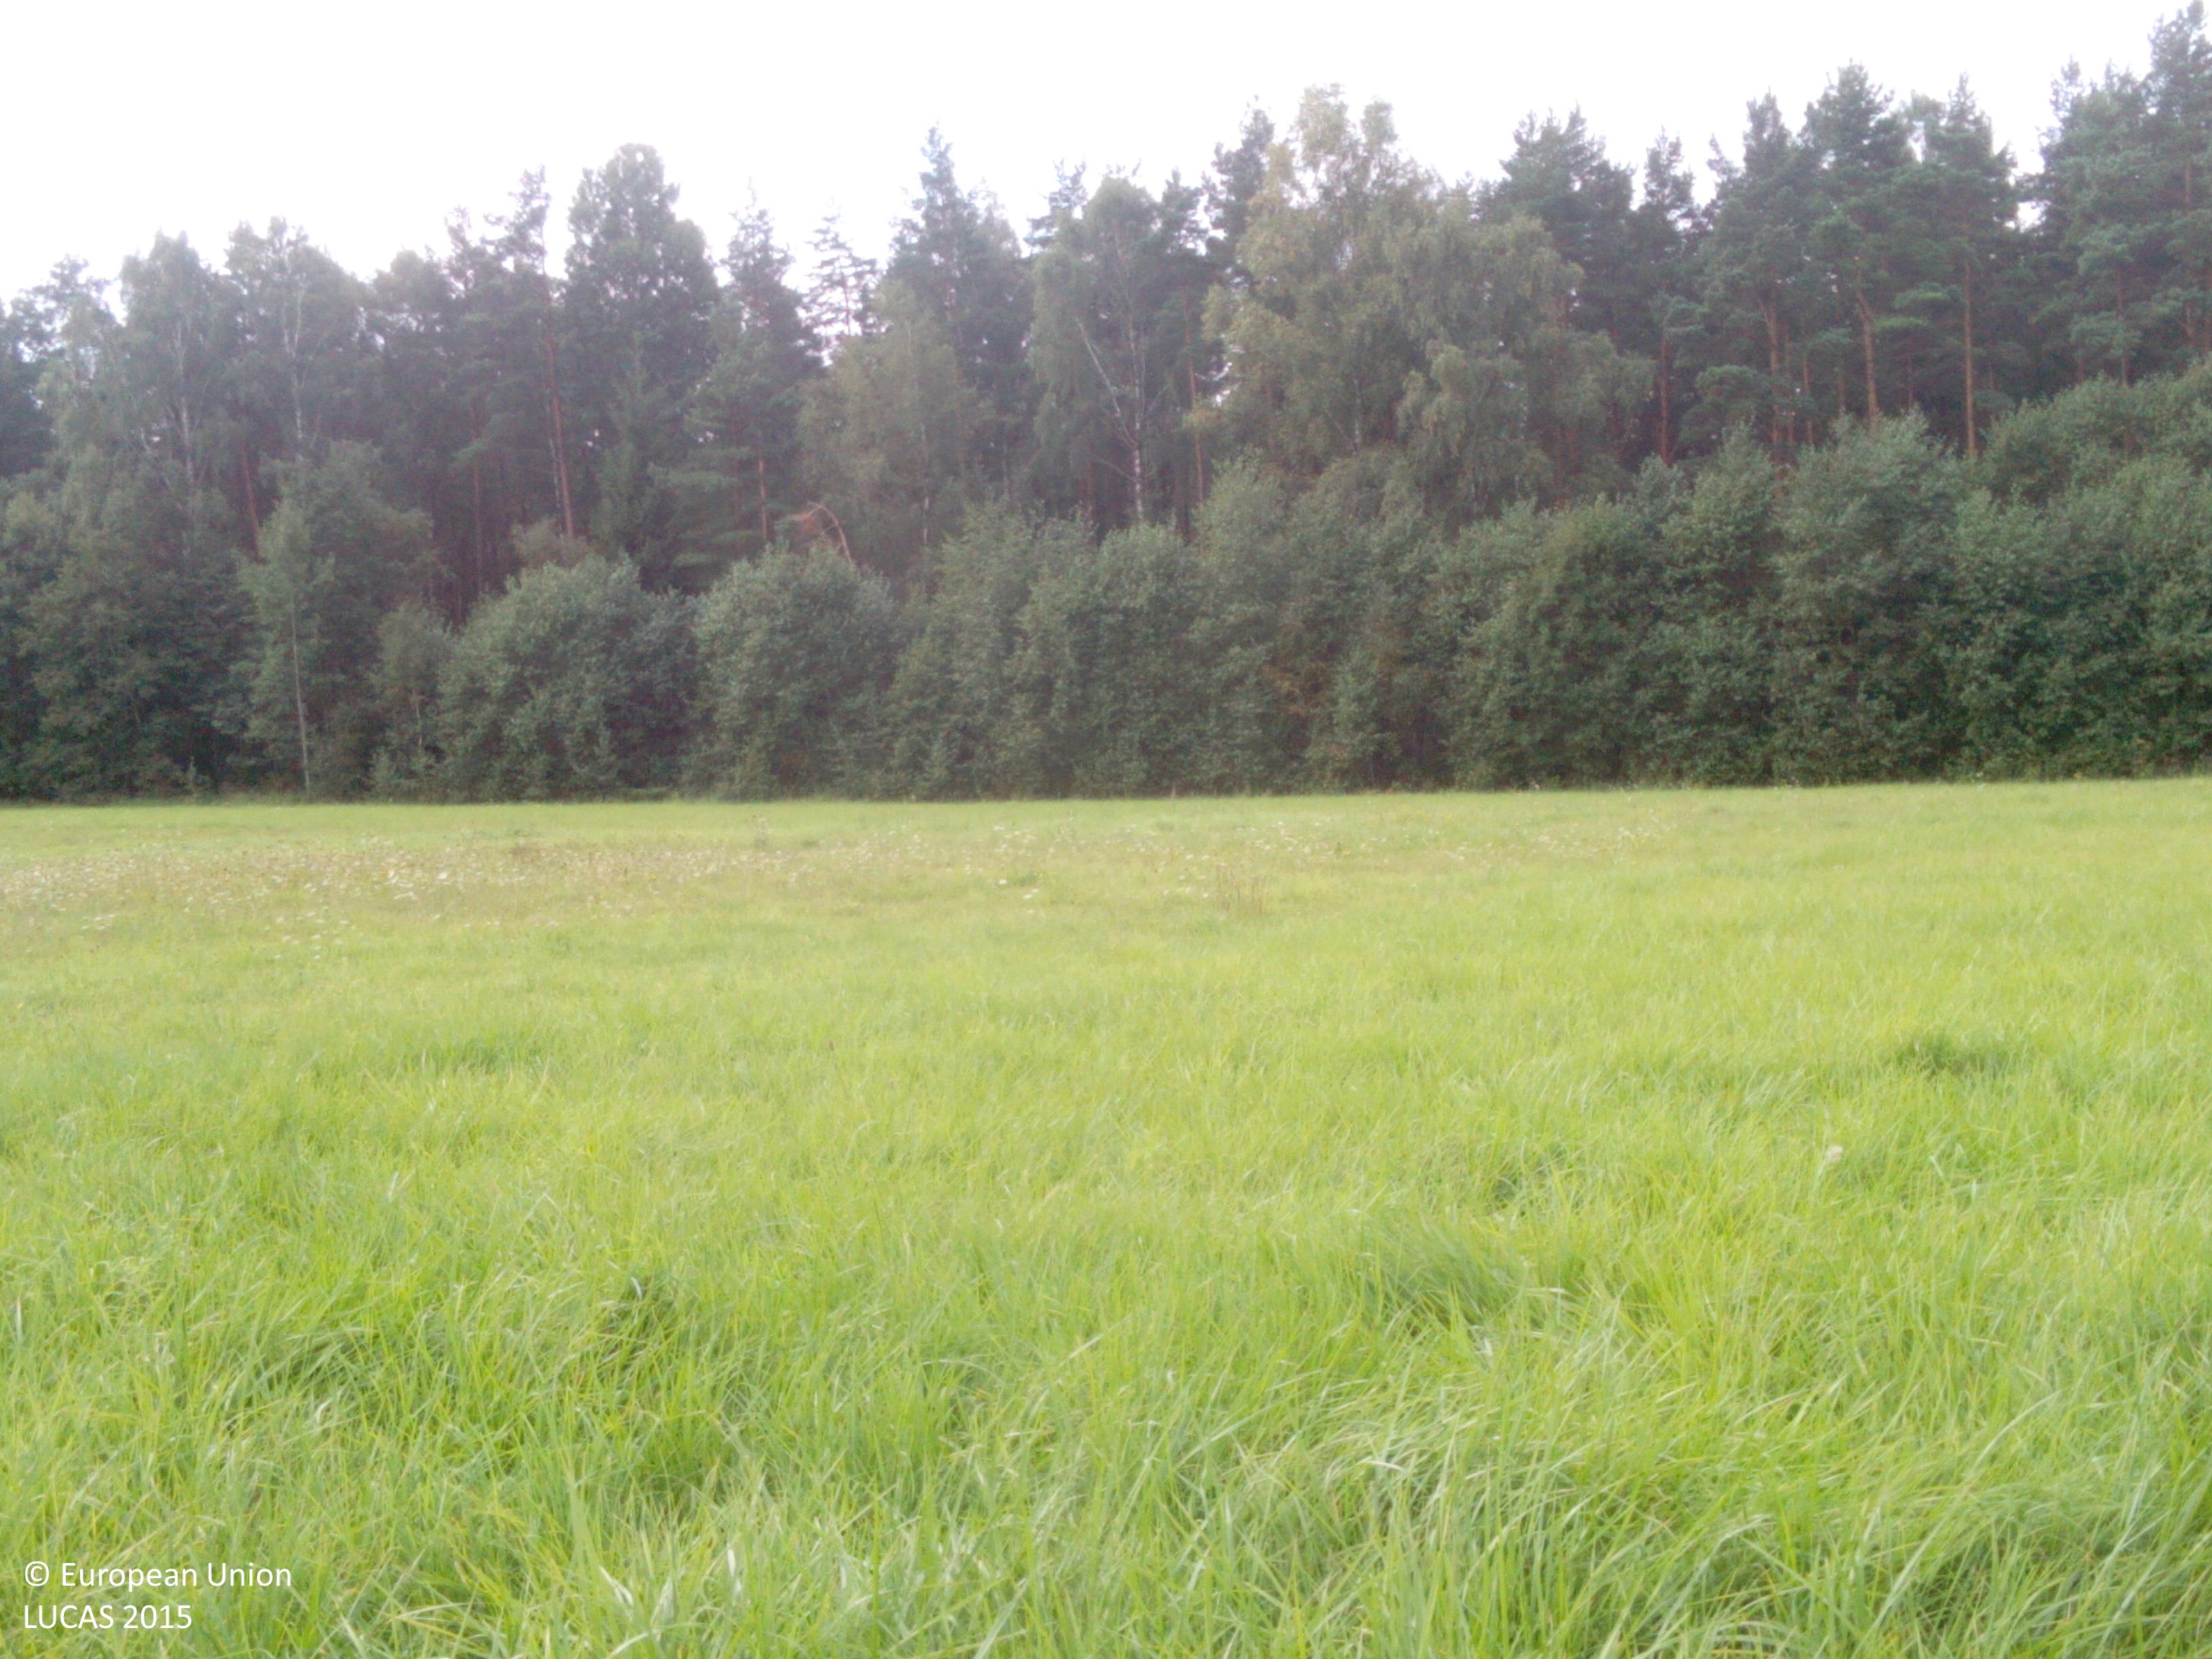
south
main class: Grassland
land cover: Grassland without tree/shrub cover
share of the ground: > 75 %
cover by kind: herbaceous plants 100 %
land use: Agriculture (excluding fallow land and kitchen gardens)
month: August
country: LV
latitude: 56.3043
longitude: 21.3054
